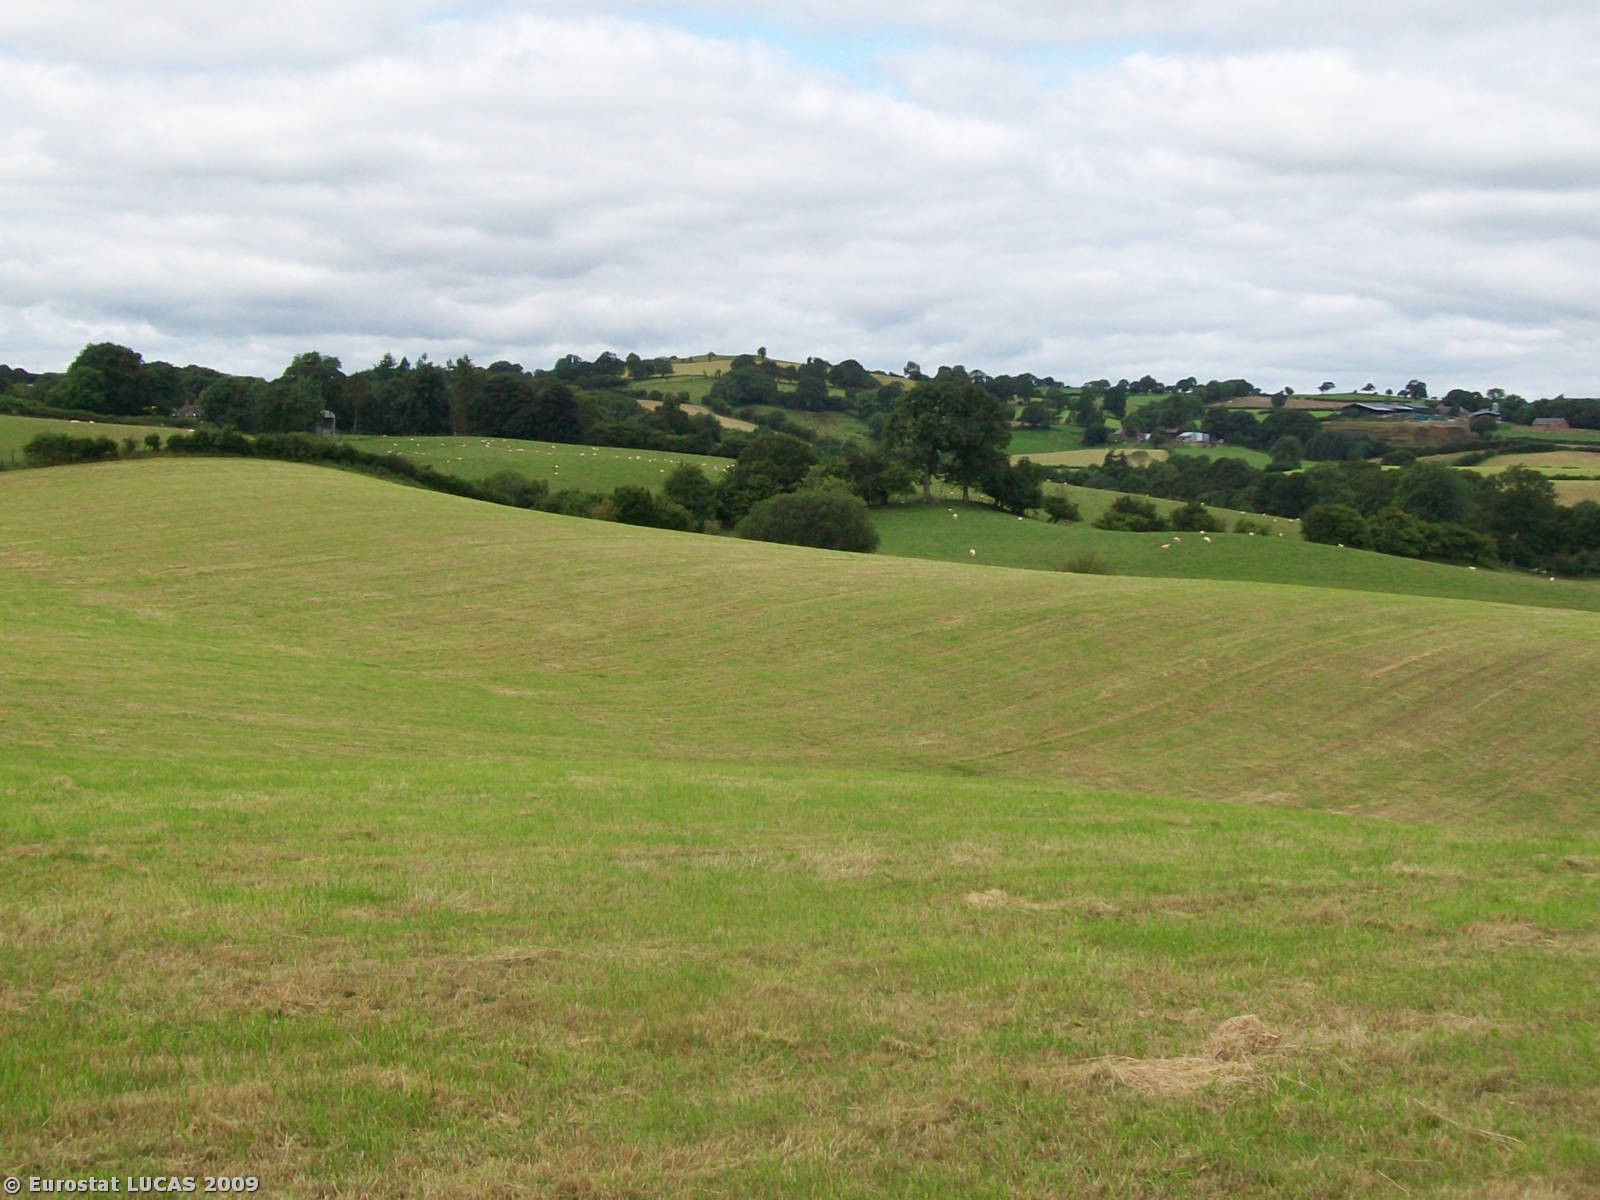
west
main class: Grassland
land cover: Grassland without tree/shrub cover
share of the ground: > 75 %
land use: Agriculture (excluding fallow land and kitchen gardens)
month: August
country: GB
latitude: 52.6030
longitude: -3.3556
